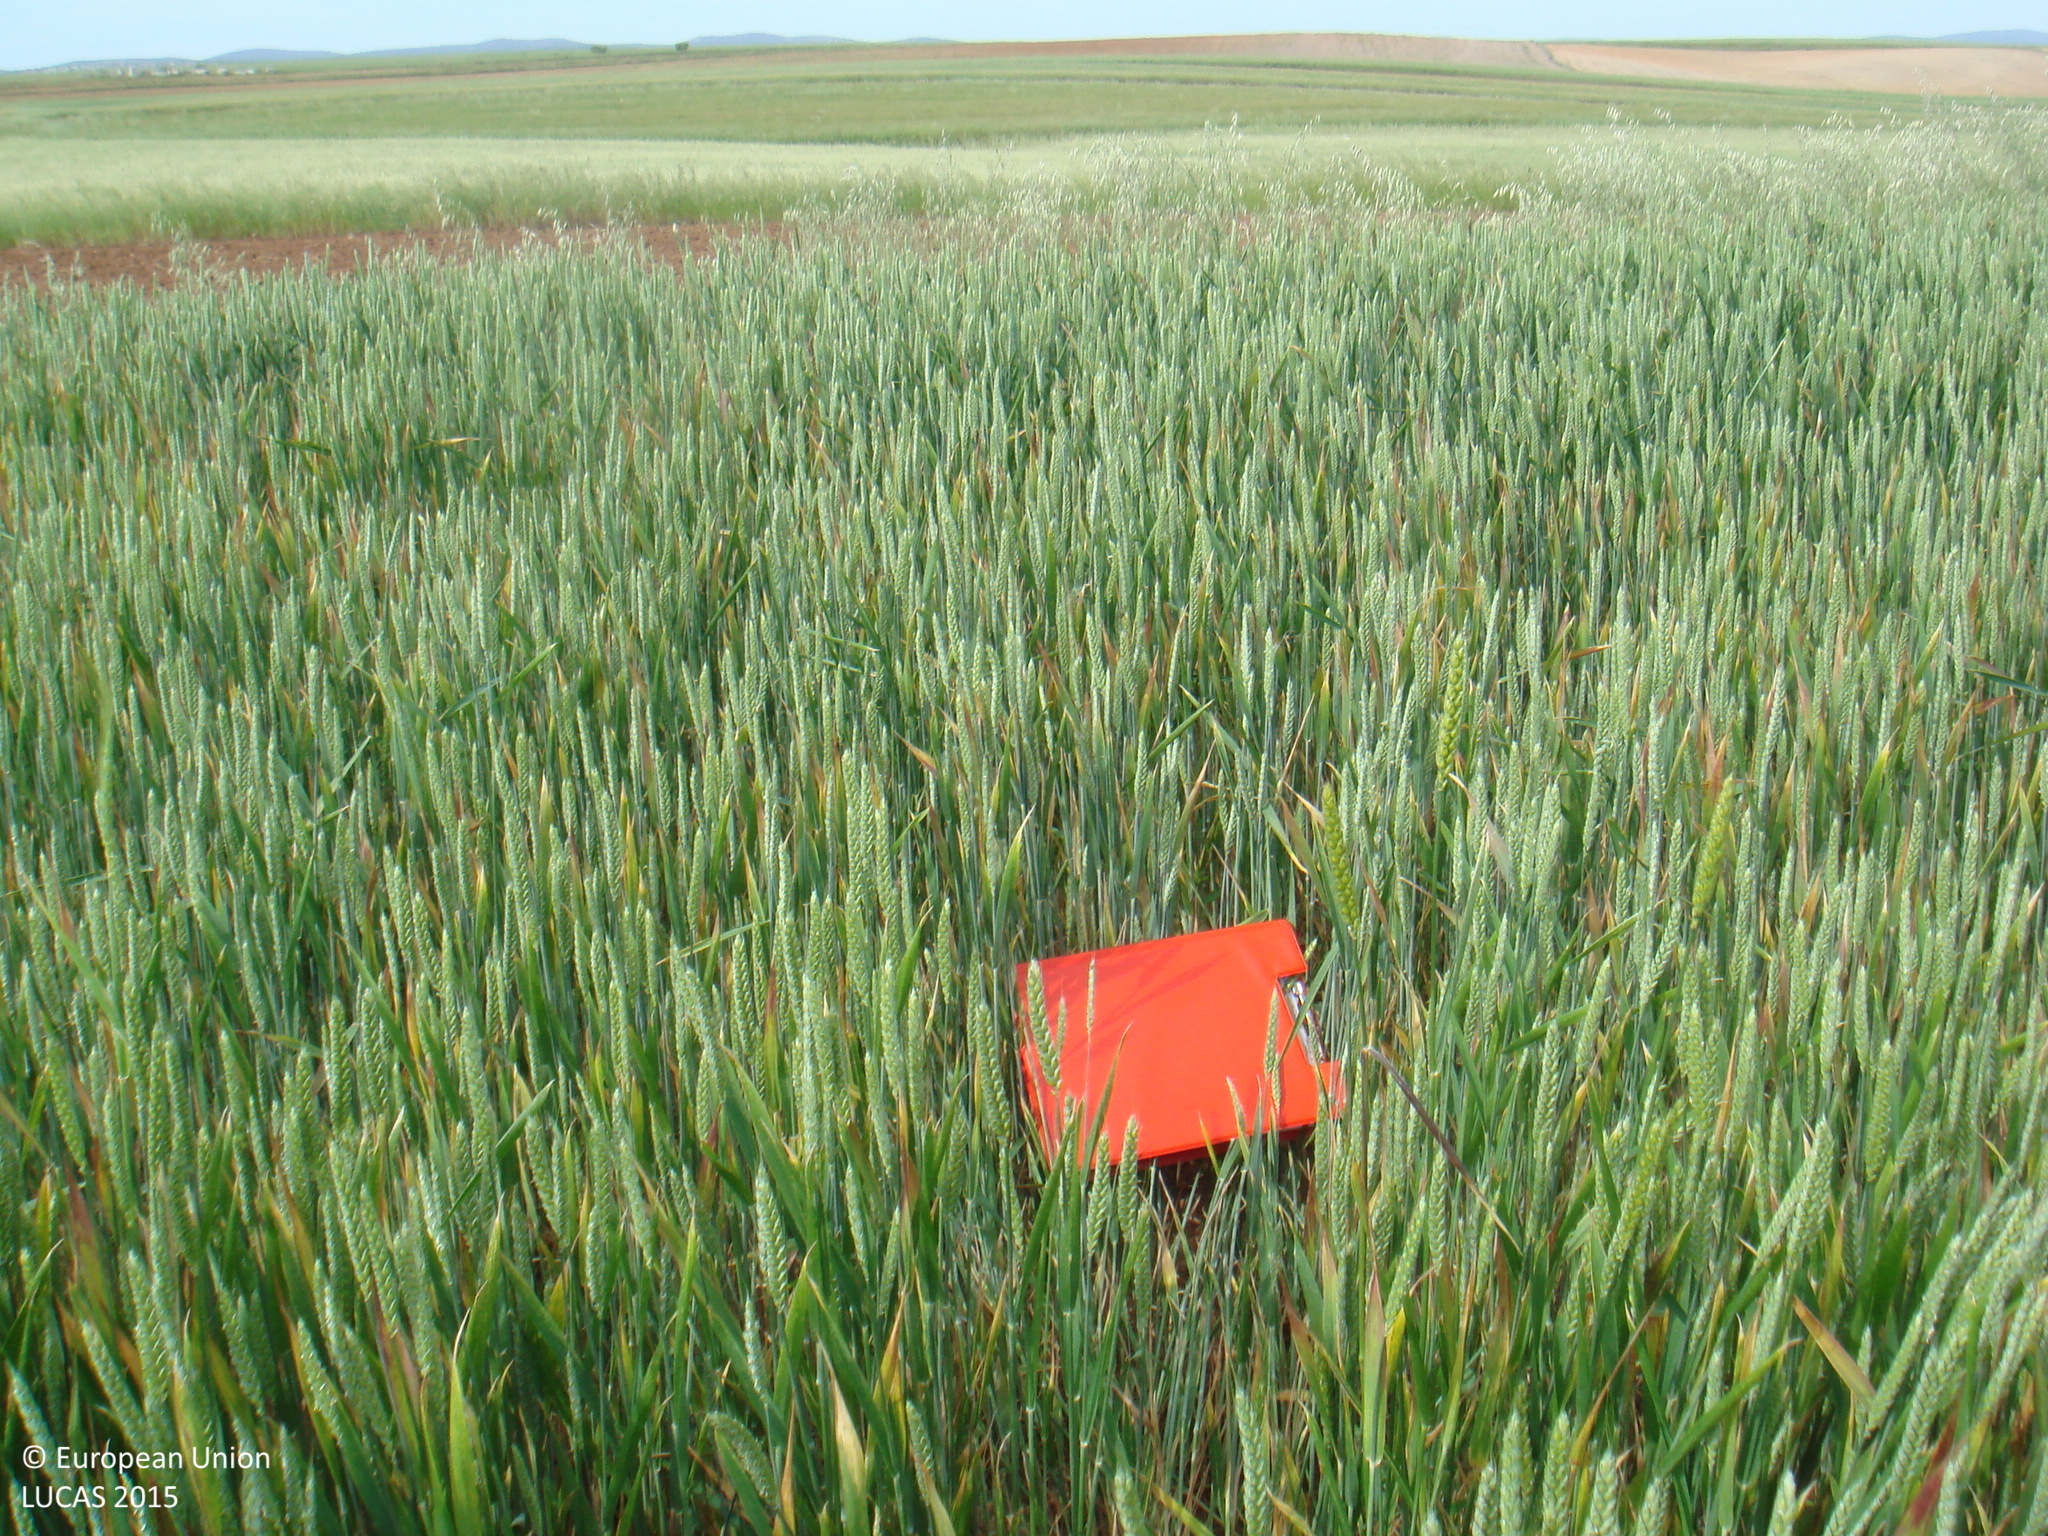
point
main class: Cropland
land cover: Common wheat
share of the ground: > 75 %
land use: Agriculture (excluding fallow land and kitchen gardens)
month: May
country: ES
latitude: 38.4591
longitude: -5.1447
